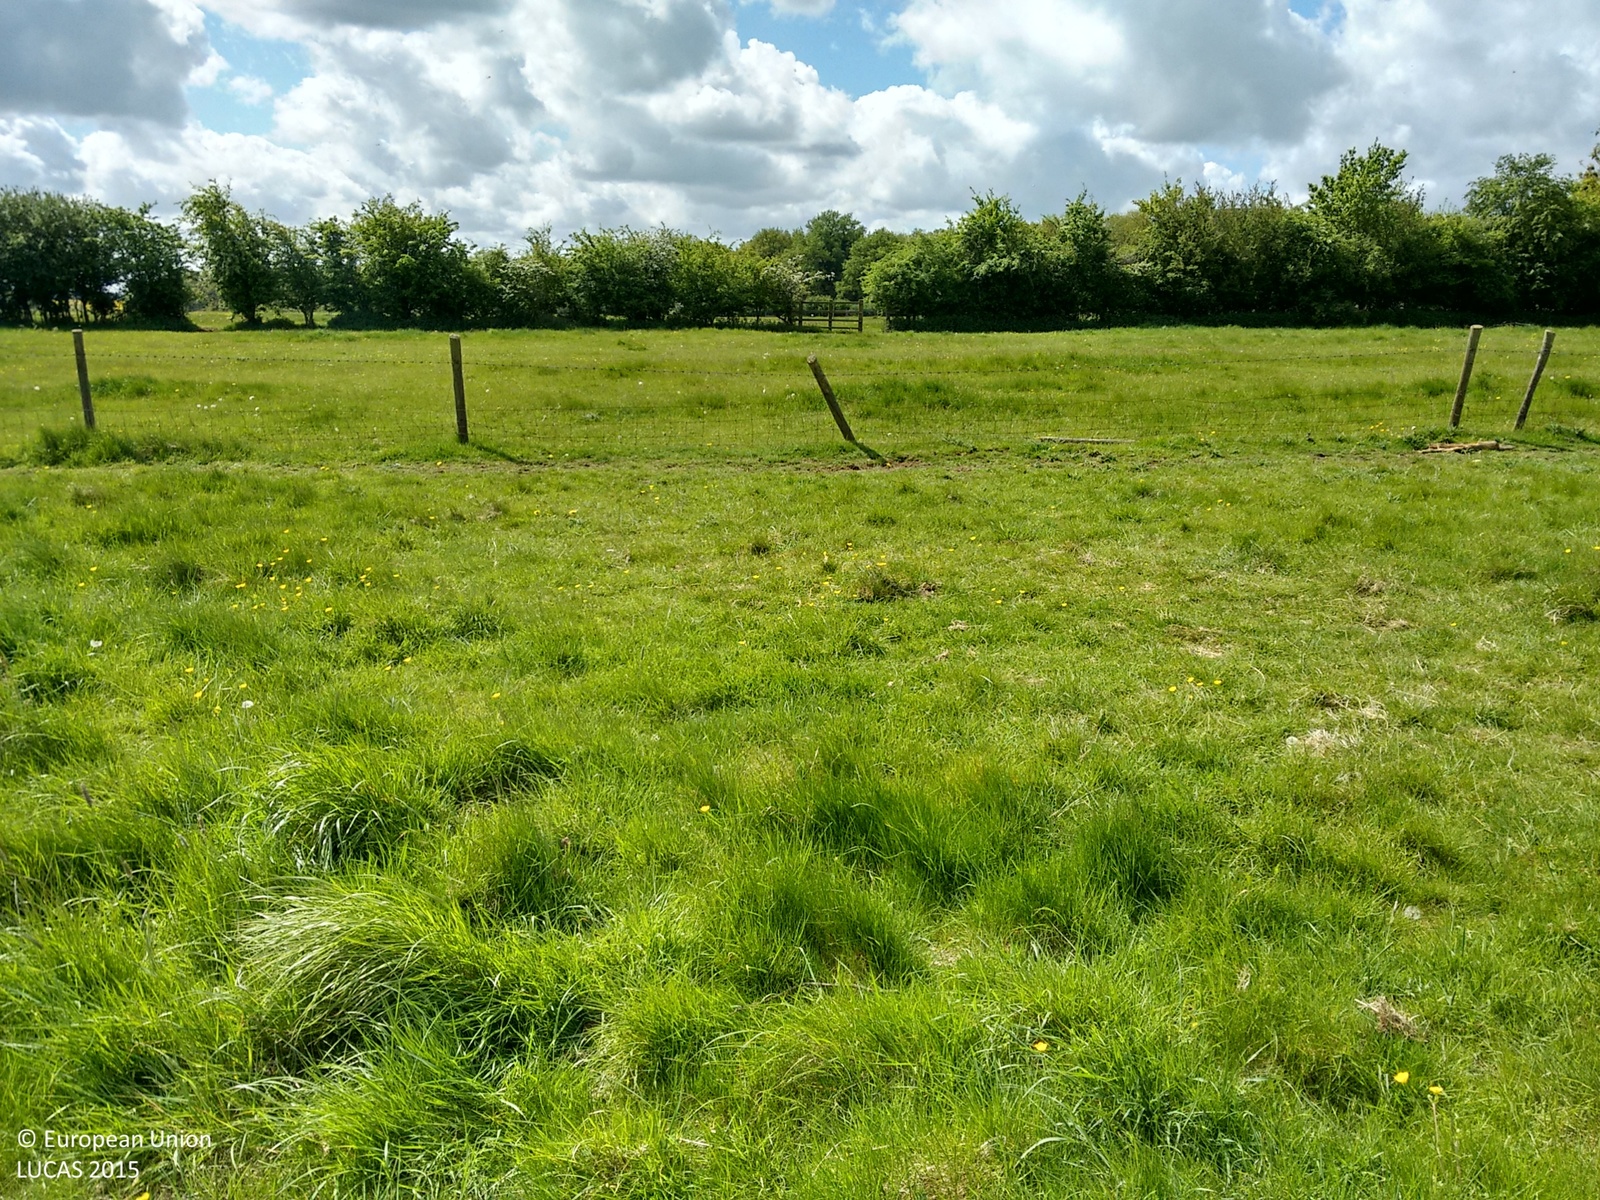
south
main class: Grassland
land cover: Grassland without tree/shrub cover
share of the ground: > 75 %
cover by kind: herbaceous plants 100 %
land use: Agriculture (excluding fallow land and kitchen gardens)
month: May
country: GB
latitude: 52.1574
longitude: -0.5782
